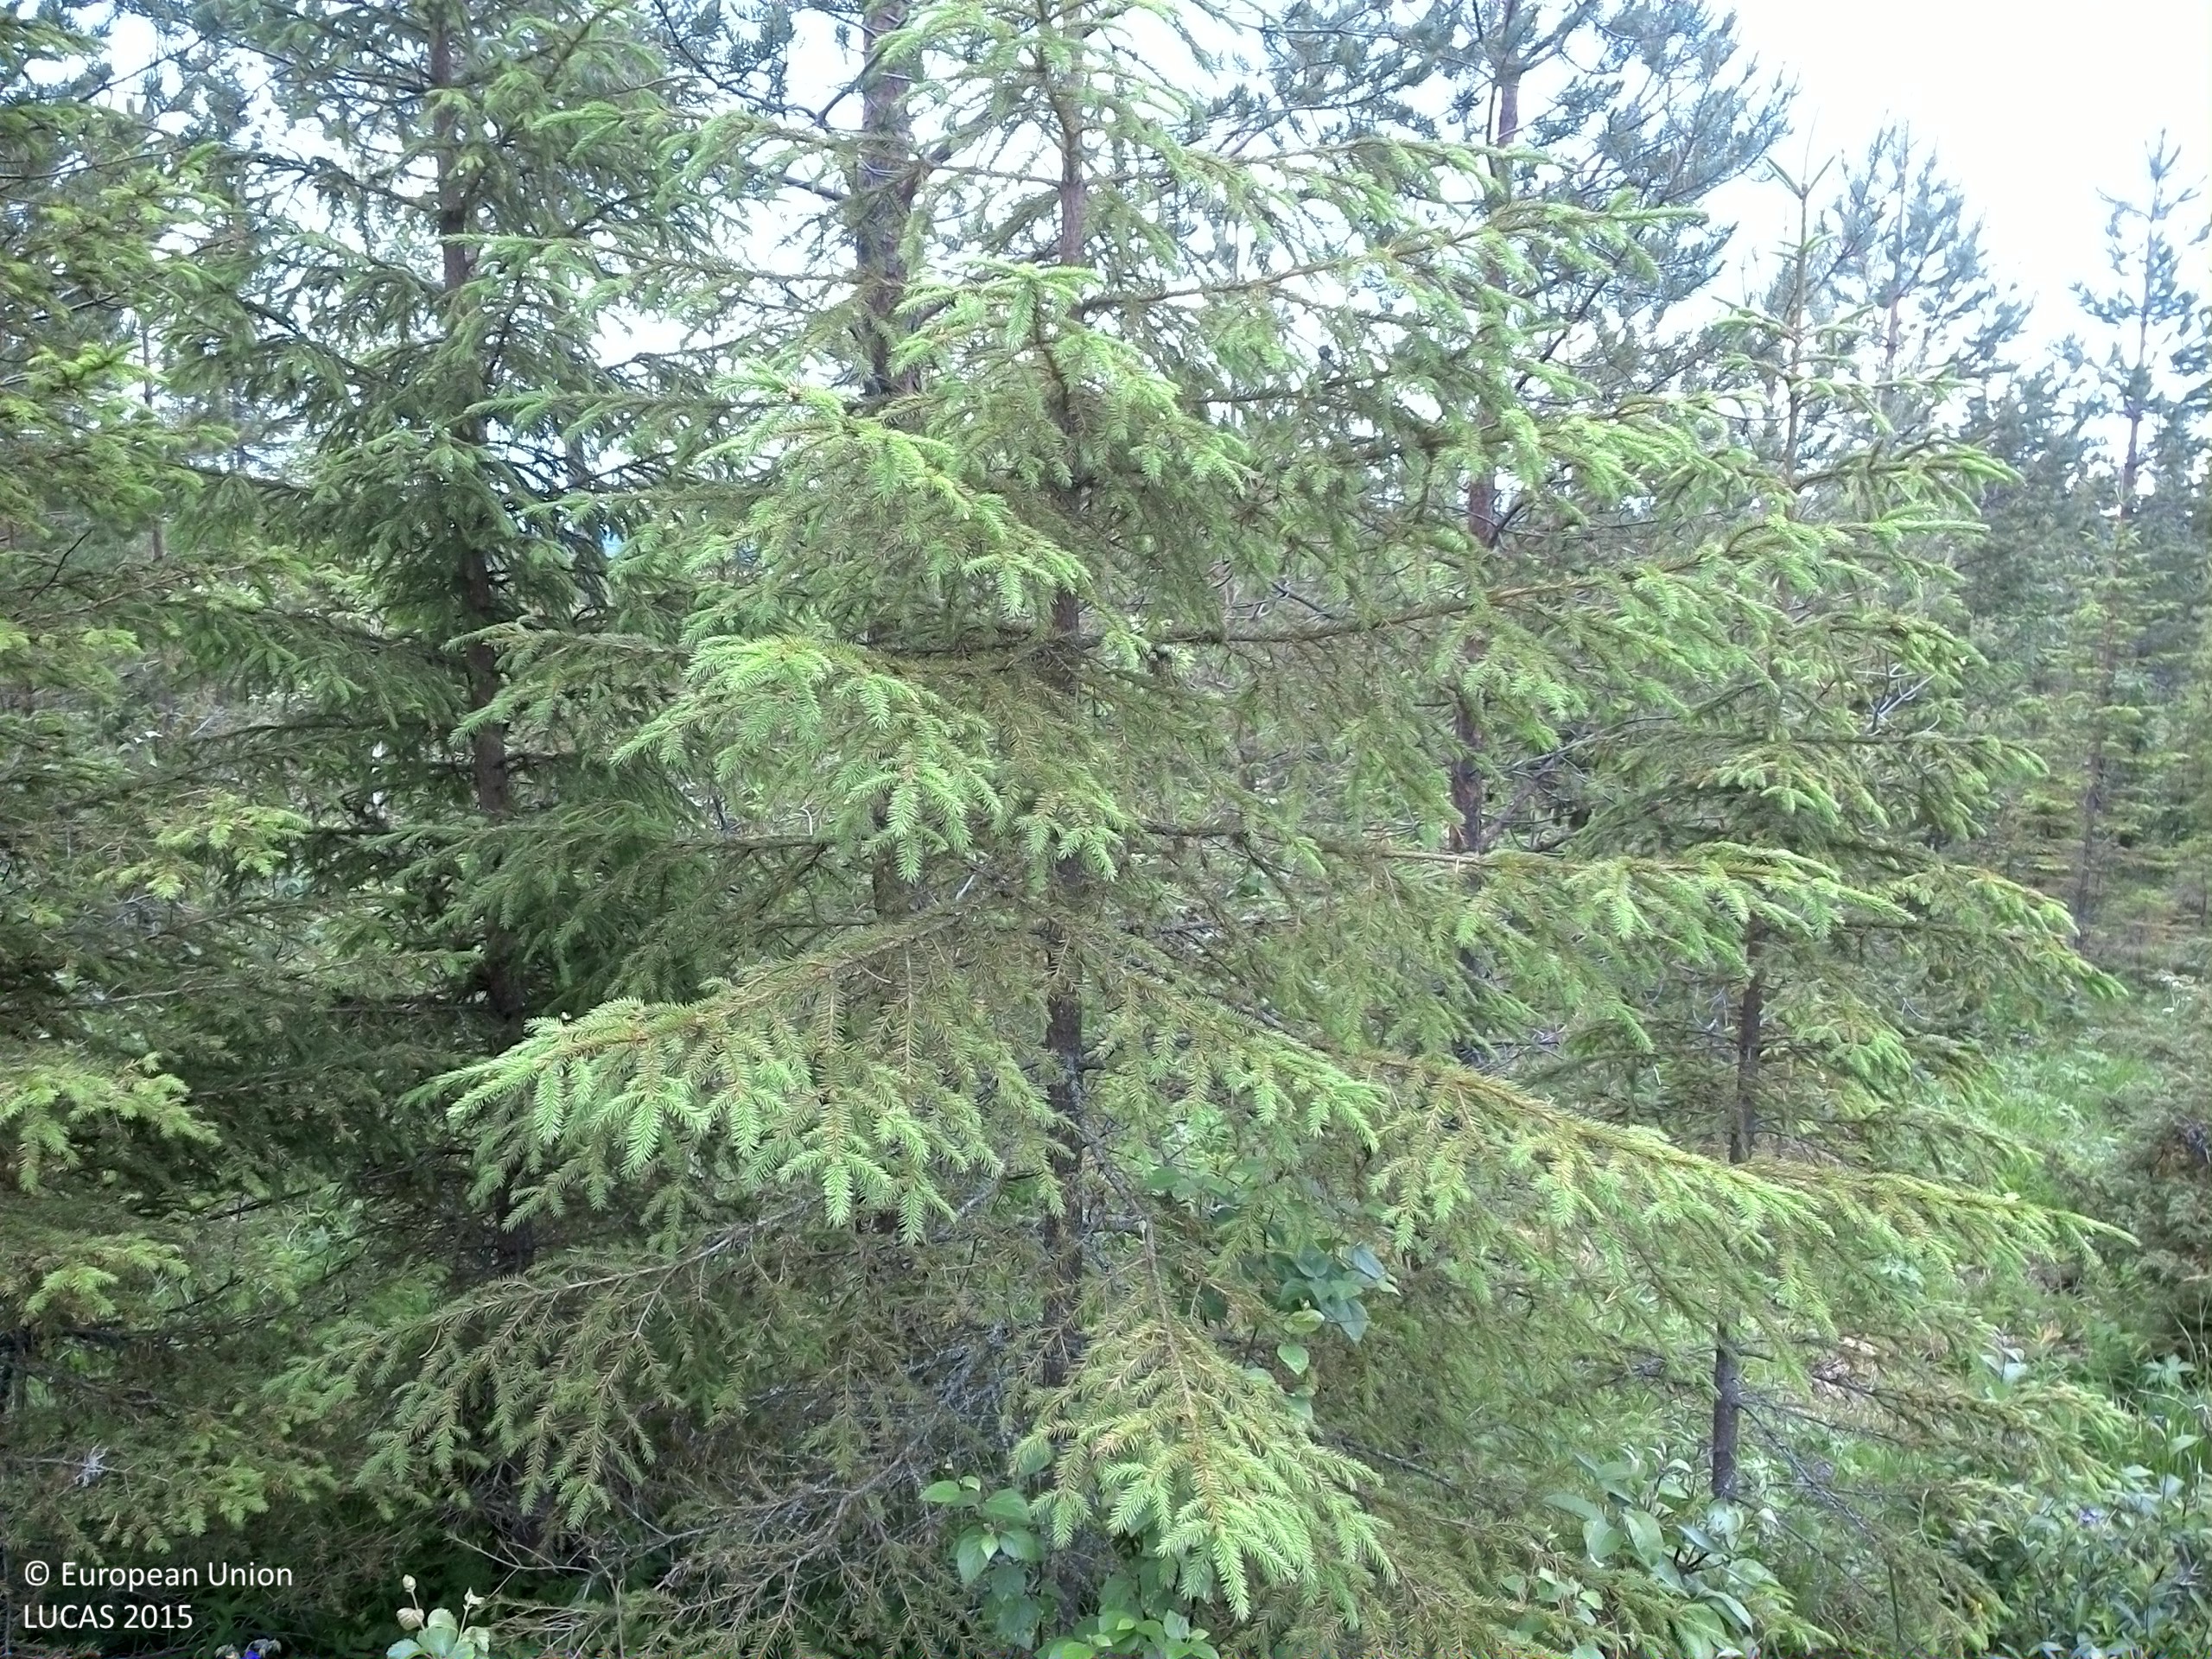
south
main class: Woodland
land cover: Pine dominated mixed woodland
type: boreal forest
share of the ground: 25 - 50 %
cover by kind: coniferous forest trees 30 %, shrubs 30 %, broadleaved forest trees 15 %, herbaceous plants 10 %, lichens and mosses 10 %, consolidated bare surface 5 %
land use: Forestry
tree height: < 5 m
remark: Clear cut
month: July
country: SE
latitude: 64.4292
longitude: 16.0117
